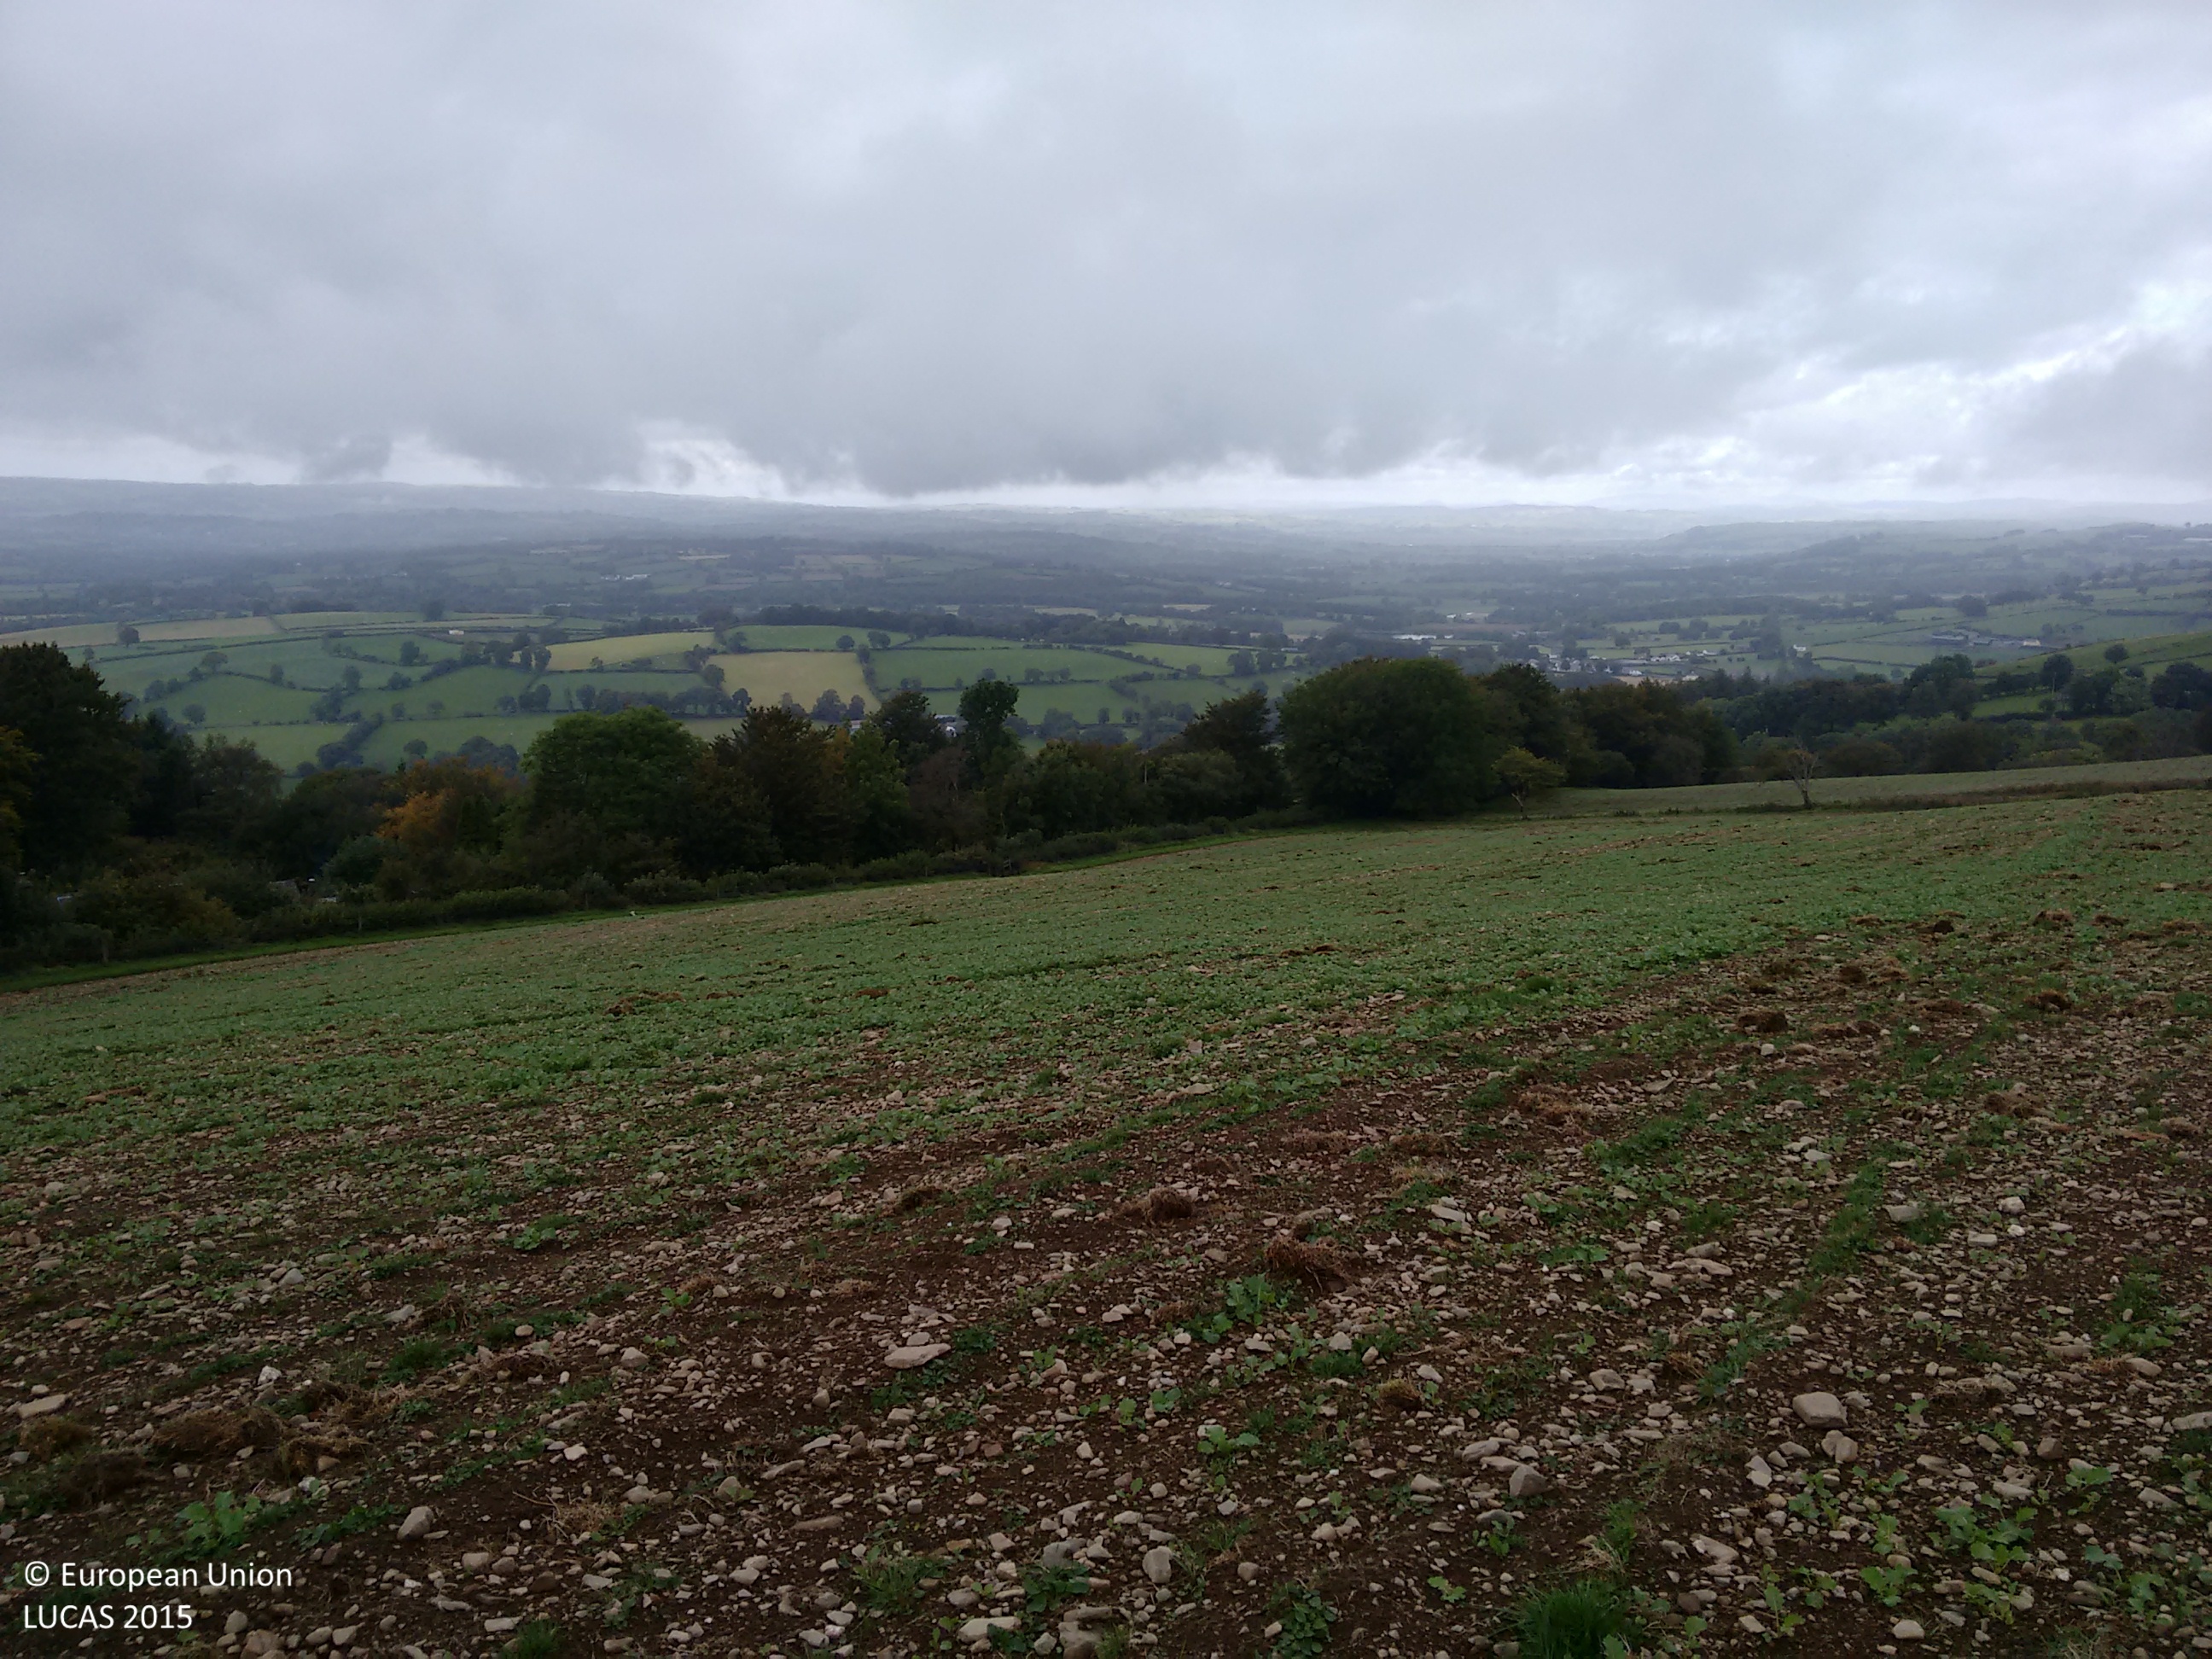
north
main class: Cropland
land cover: Other root crops
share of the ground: 25 - 50 %
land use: Agriculture (excluding fallow land and kitchen gardens)
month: September
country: GB
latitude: 52.1669
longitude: -3.9687
